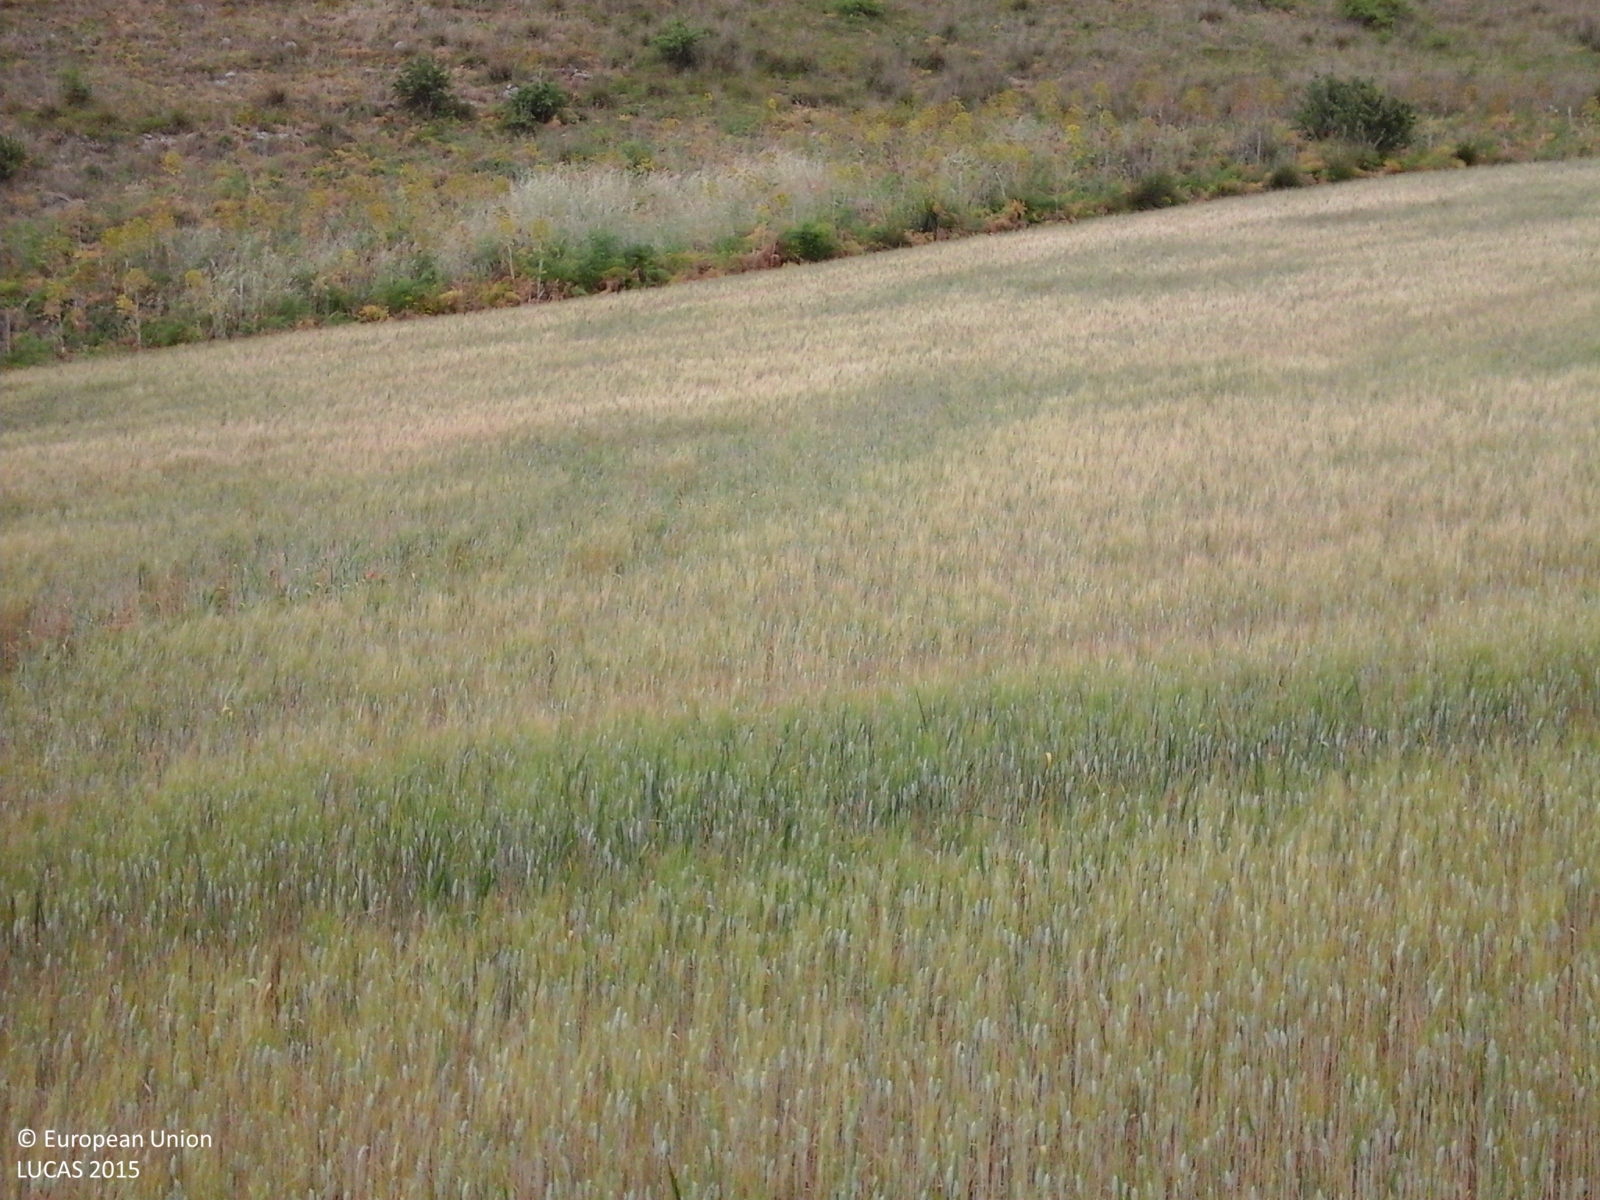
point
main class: Cropland
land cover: Durum wheat
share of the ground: > 75 %
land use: Agriculture (excluding fallow land and kitchen gardens)
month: May
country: IT
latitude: 37.6636
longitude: 13.9952
